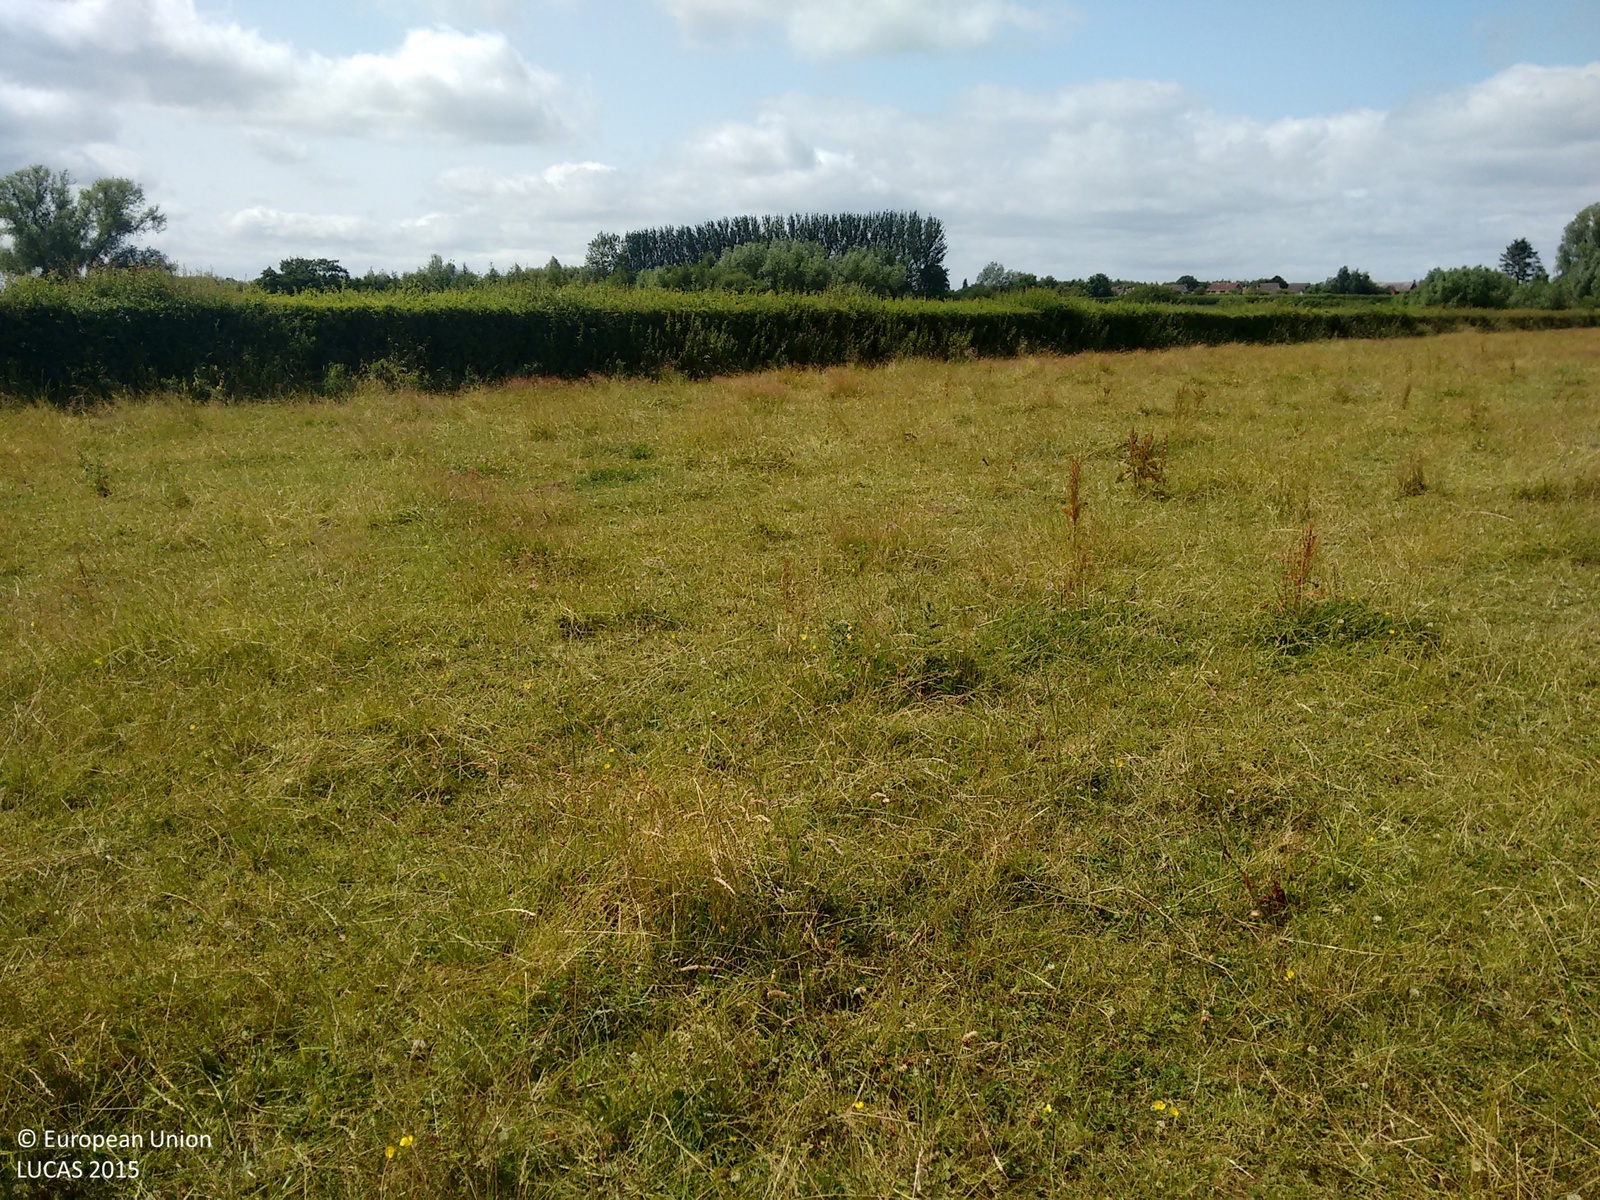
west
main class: Grassland
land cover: Grassland without tree/shrub cover
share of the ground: > 75 %
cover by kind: herbaceous plants 100 %
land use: Agriculture (excluding fallow land and kitchen gardens)
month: July
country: GB
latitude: 52.2103
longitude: -2.7888
